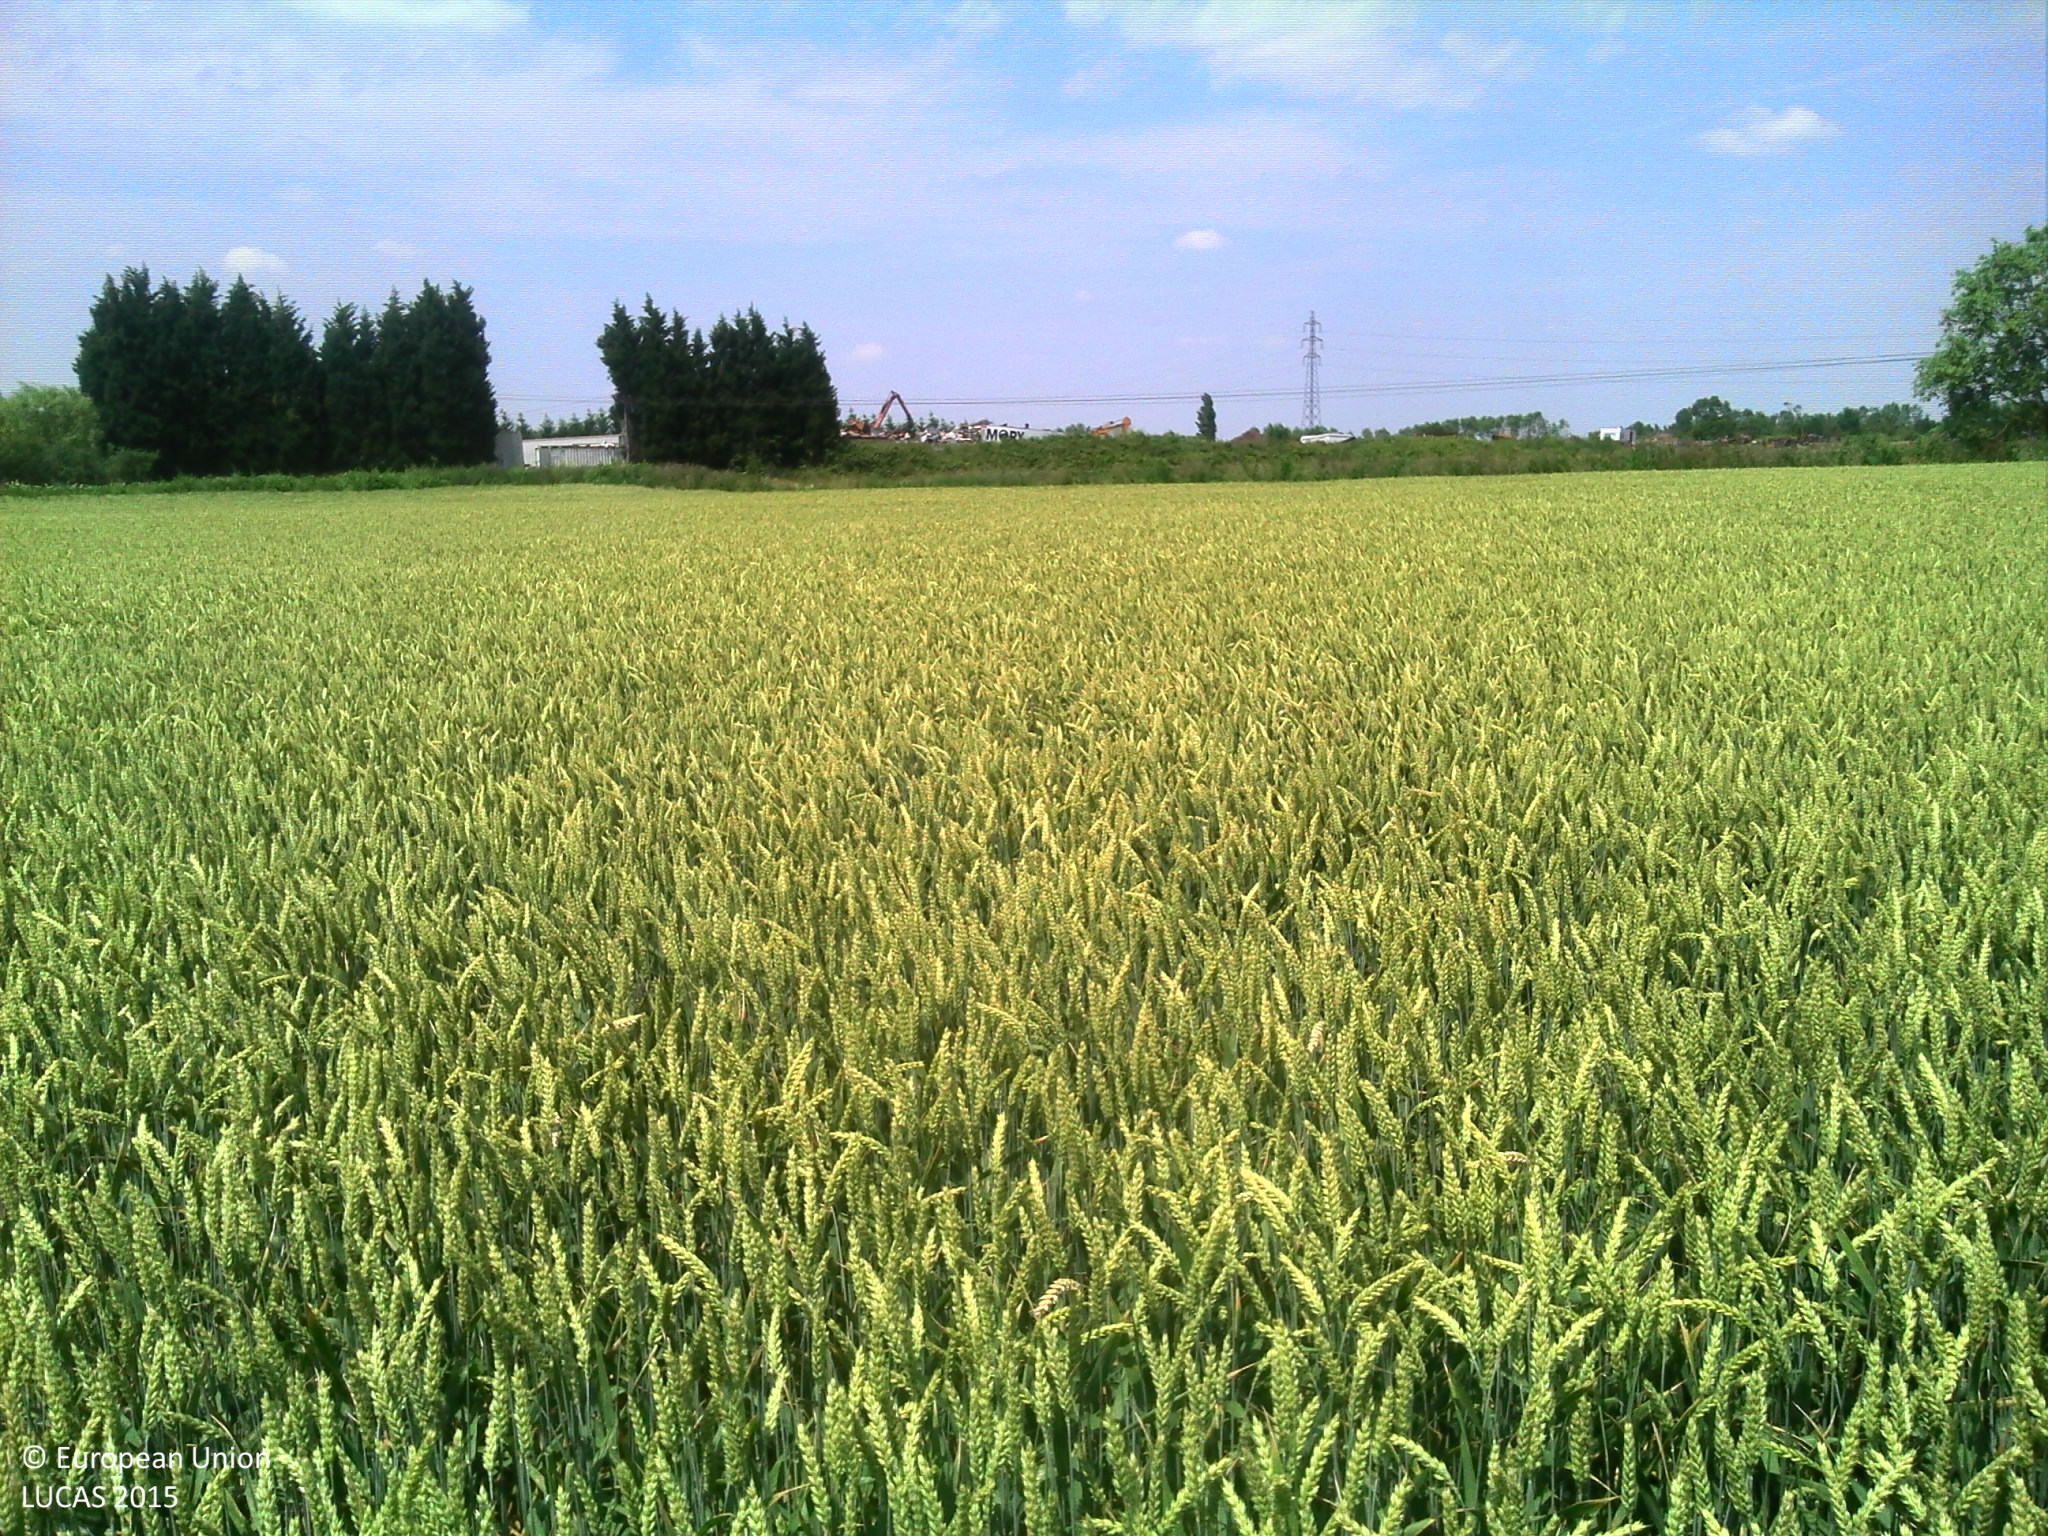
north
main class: Cropland
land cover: Common wheat
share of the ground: > 75 %
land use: Agriculture (excluding fallow land and kitchen gardens)
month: June
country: FR
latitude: 45.9529
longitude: -0.9301
